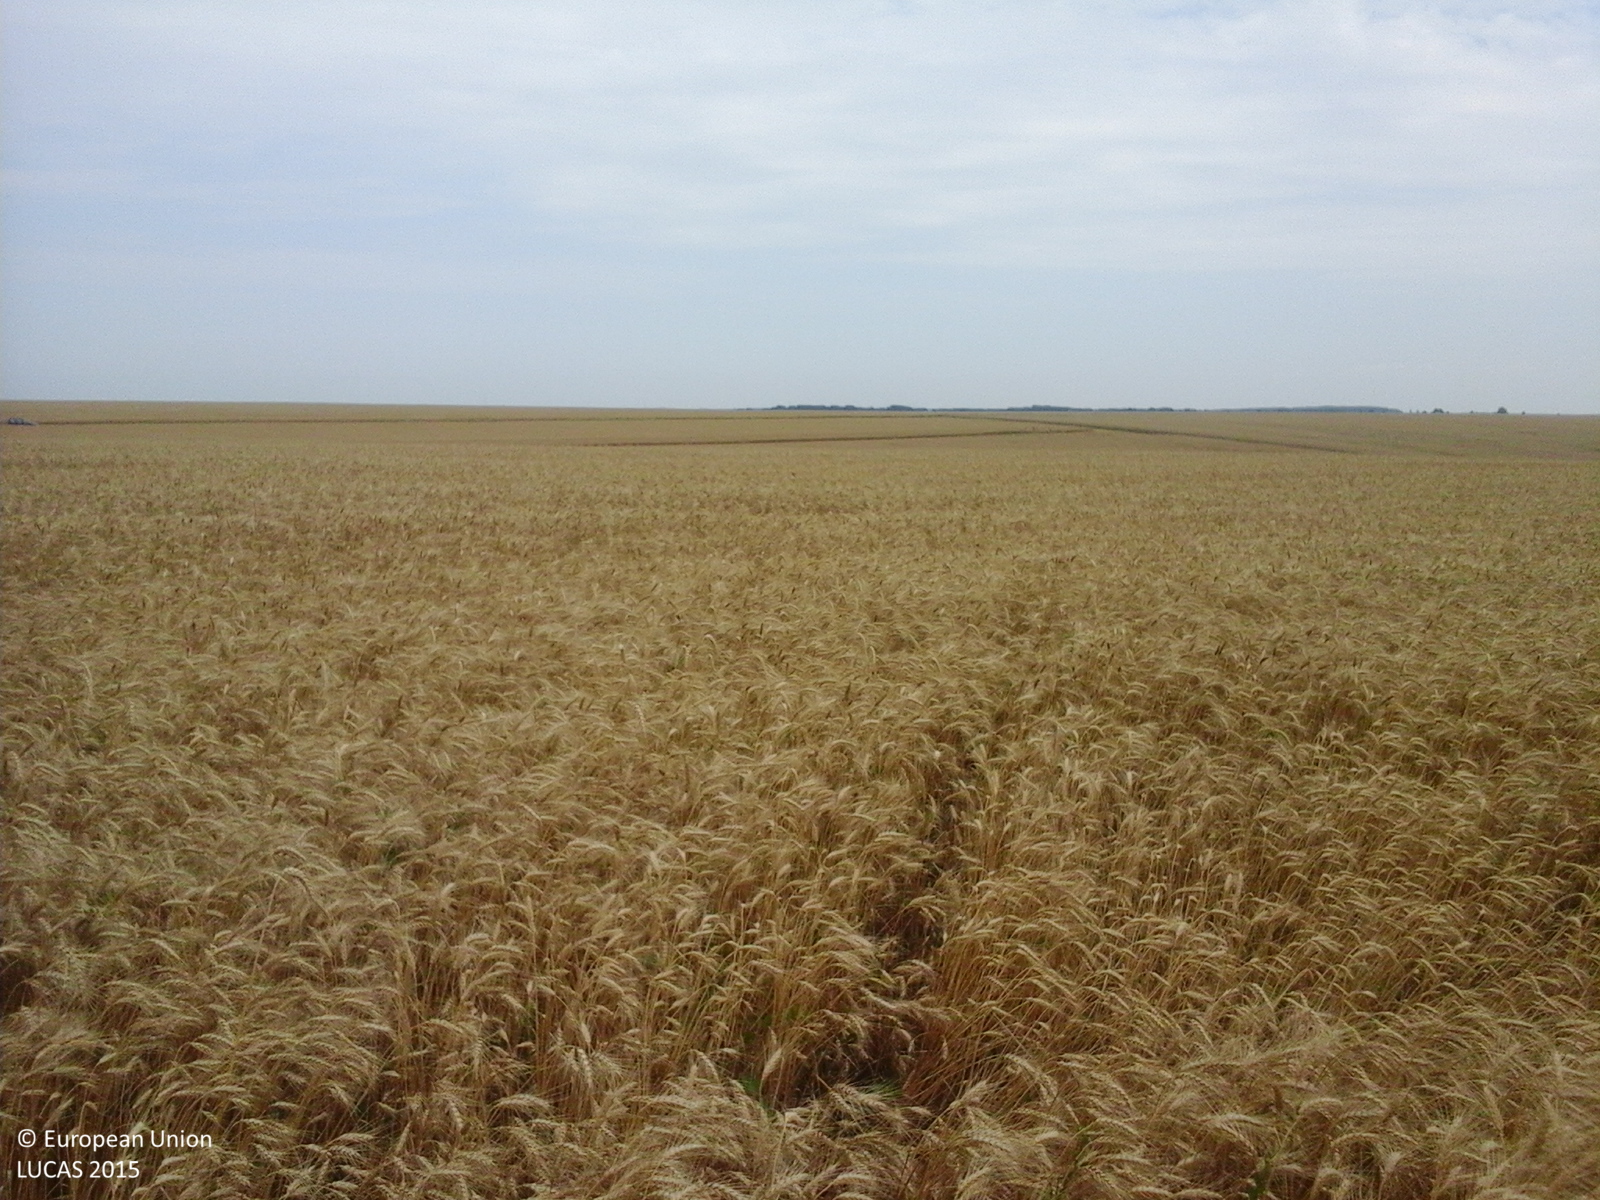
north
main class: Cropland
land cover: Common wheat
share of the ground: > 75 %
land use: Agriculture (excluding fallow land and kitchen gardens)
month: July
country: RO
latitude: 44.1252
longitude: 25.7783
